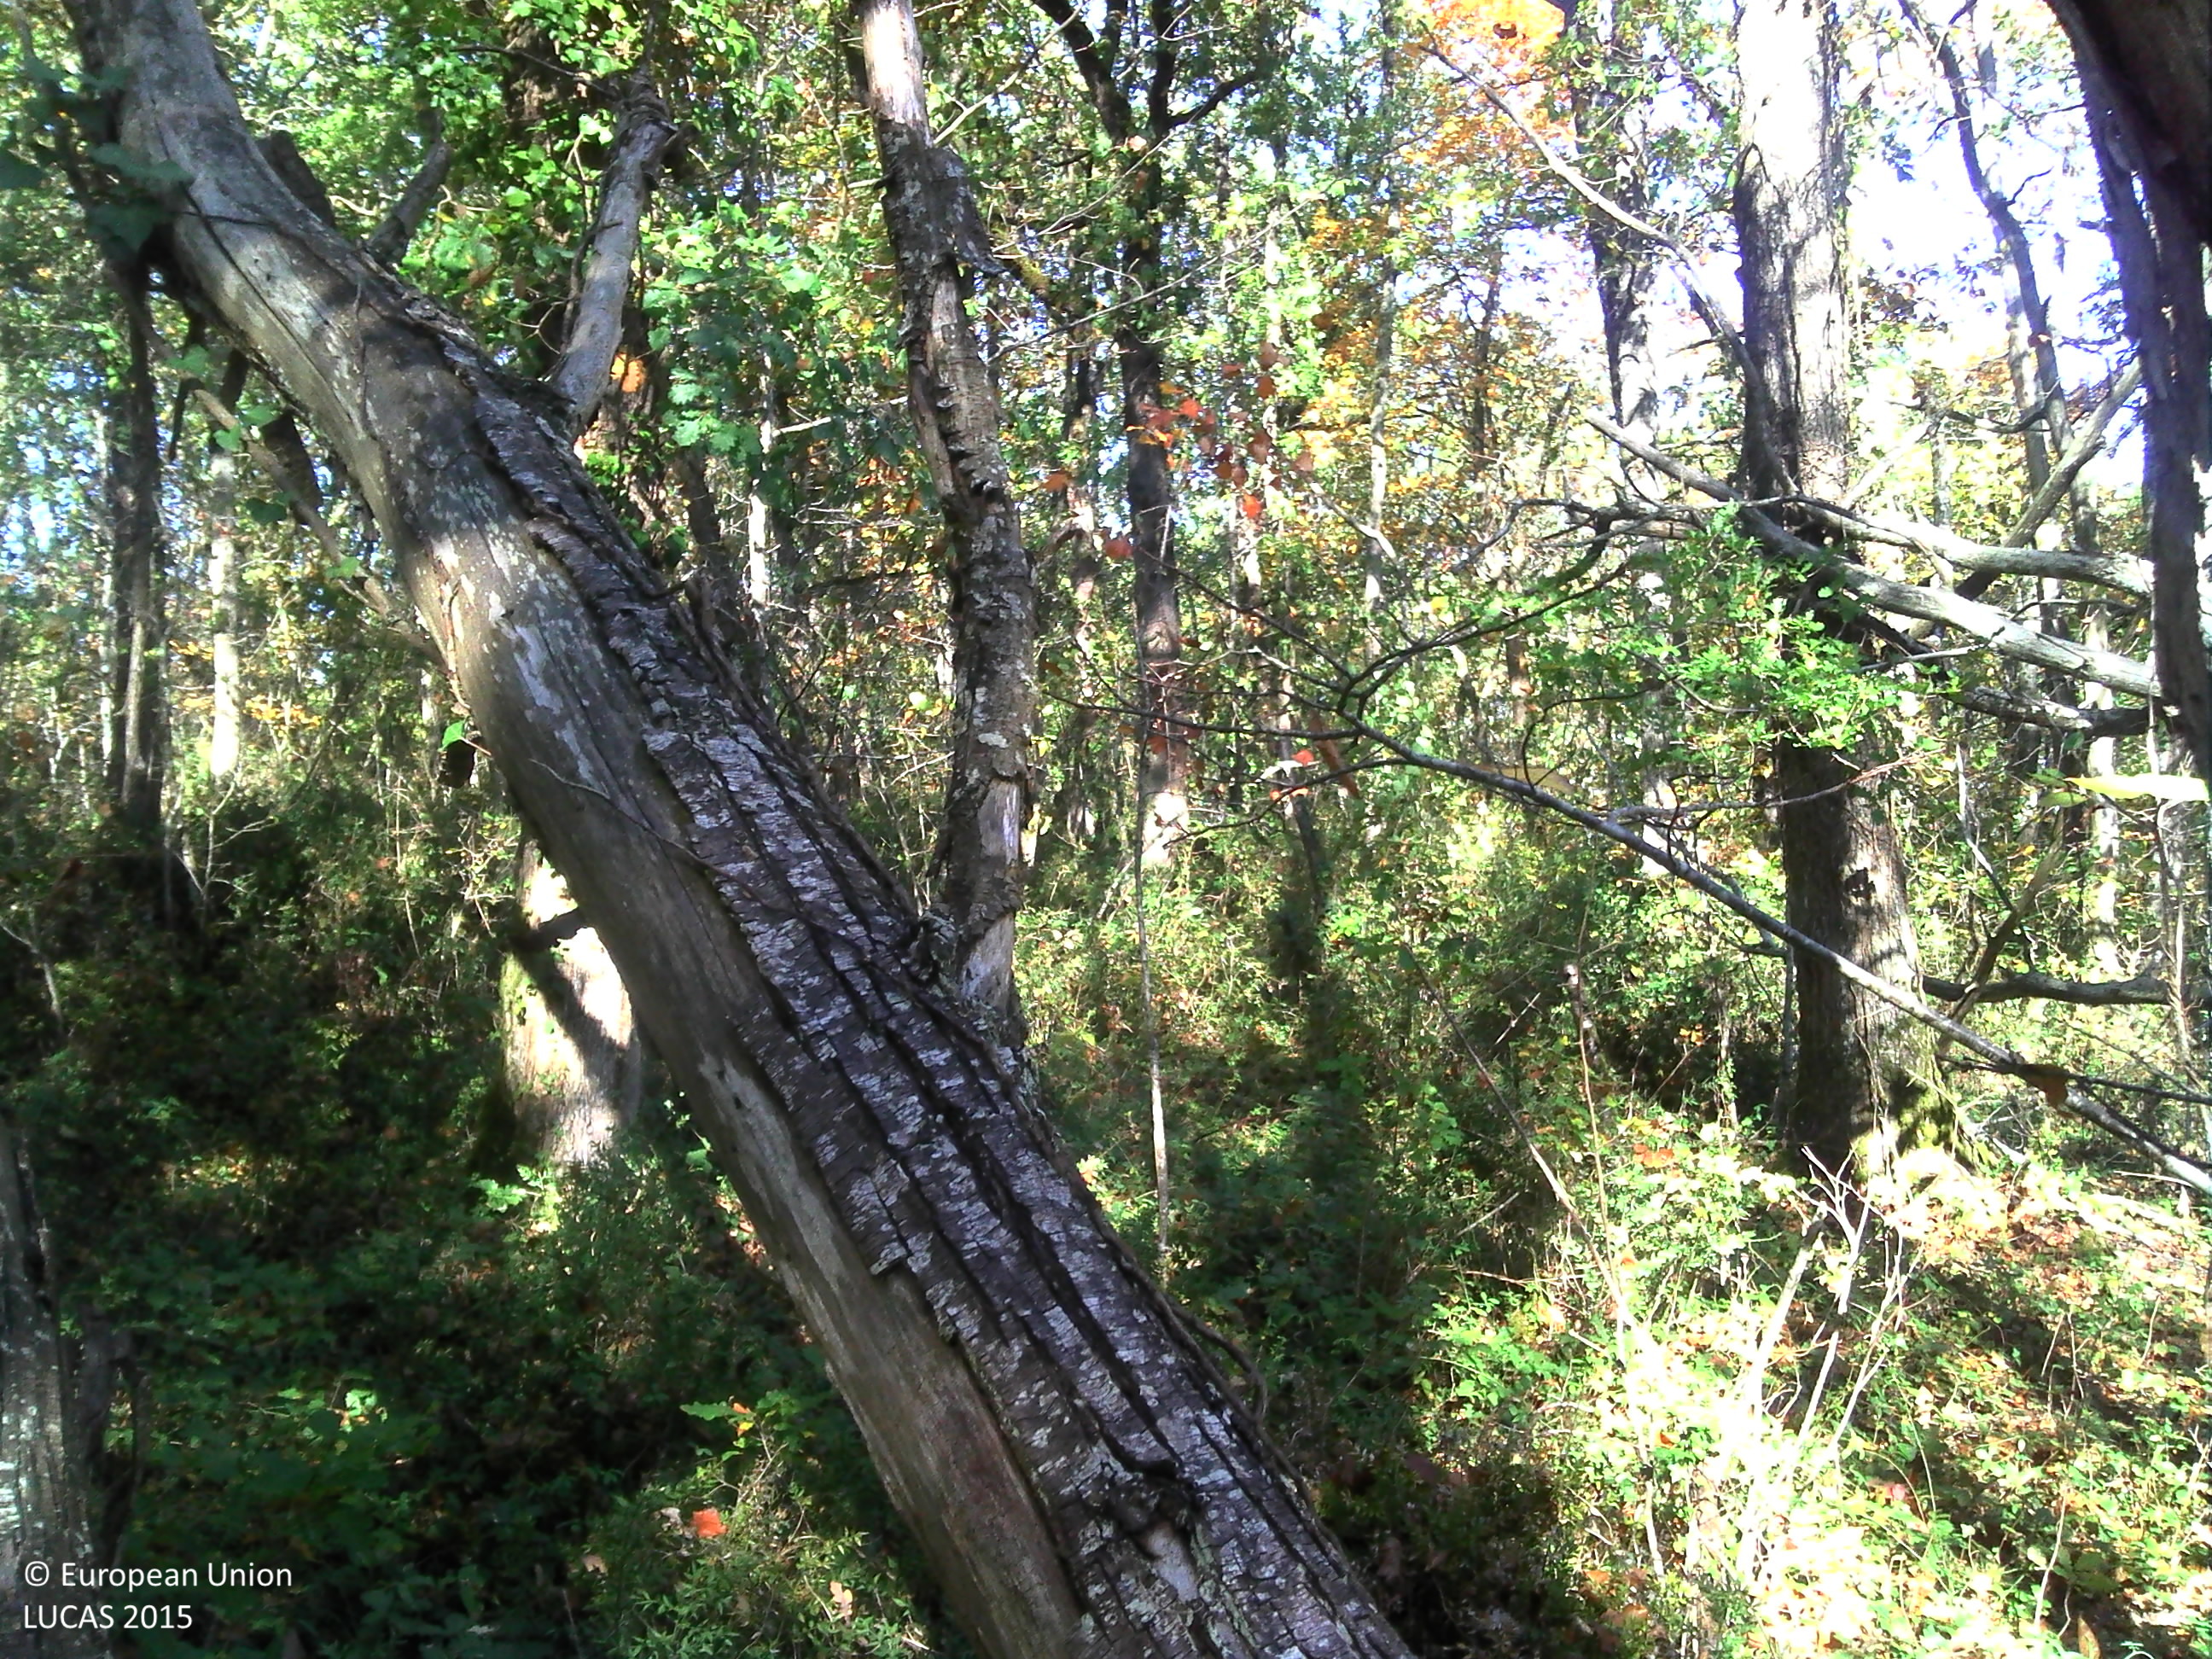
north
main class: Woodland
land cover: Broadleaved woodland
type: mesophytic deciduous forest
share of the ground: > 75 %
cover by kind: broadleaved forest trees 75 %, shrubs 15 %, herbaceous plants 5 %
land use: Forestry
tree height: > 5 m
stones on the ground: < 10 %
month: October
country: FR
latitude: 44.0206
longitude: 0.8779
